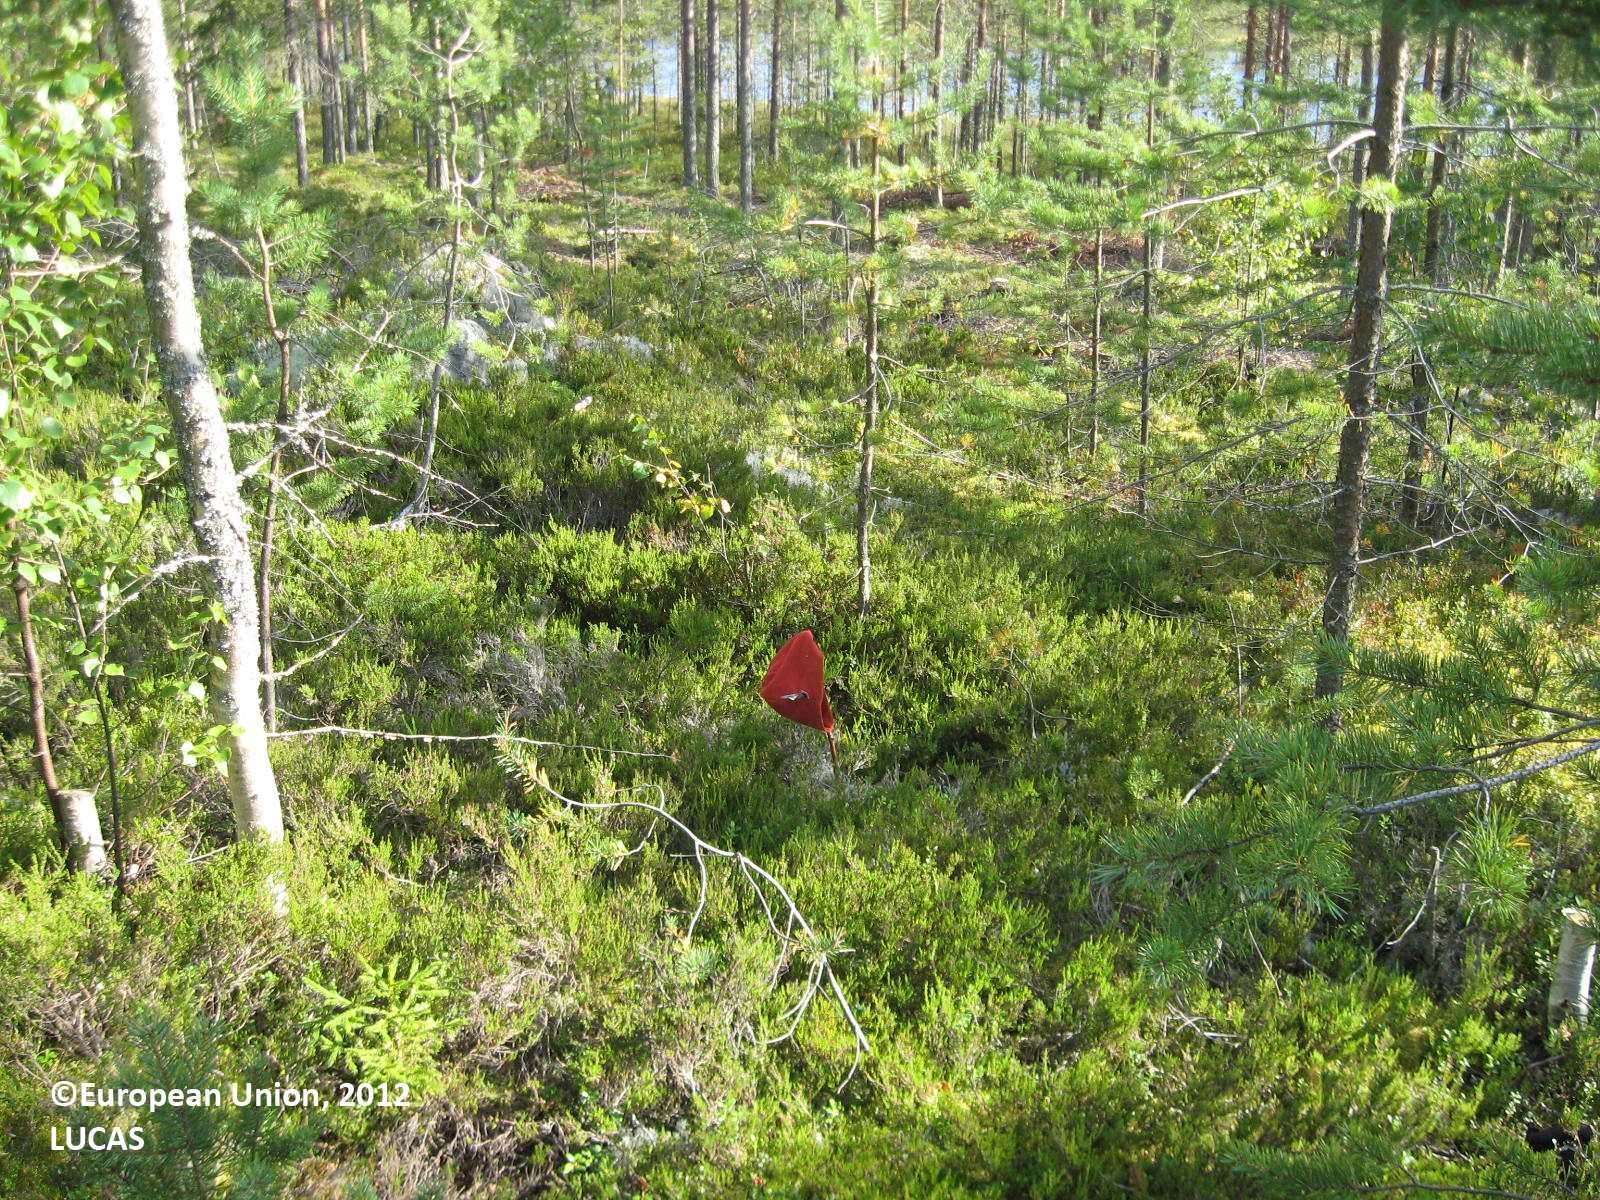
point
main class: Woodland
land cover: Pine dominated mixed woodland
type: boreal forest
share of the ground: > 75 %
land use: Forestry
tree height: > 5 m
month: August
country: FI
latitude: 63.6382
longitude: 29.6287
